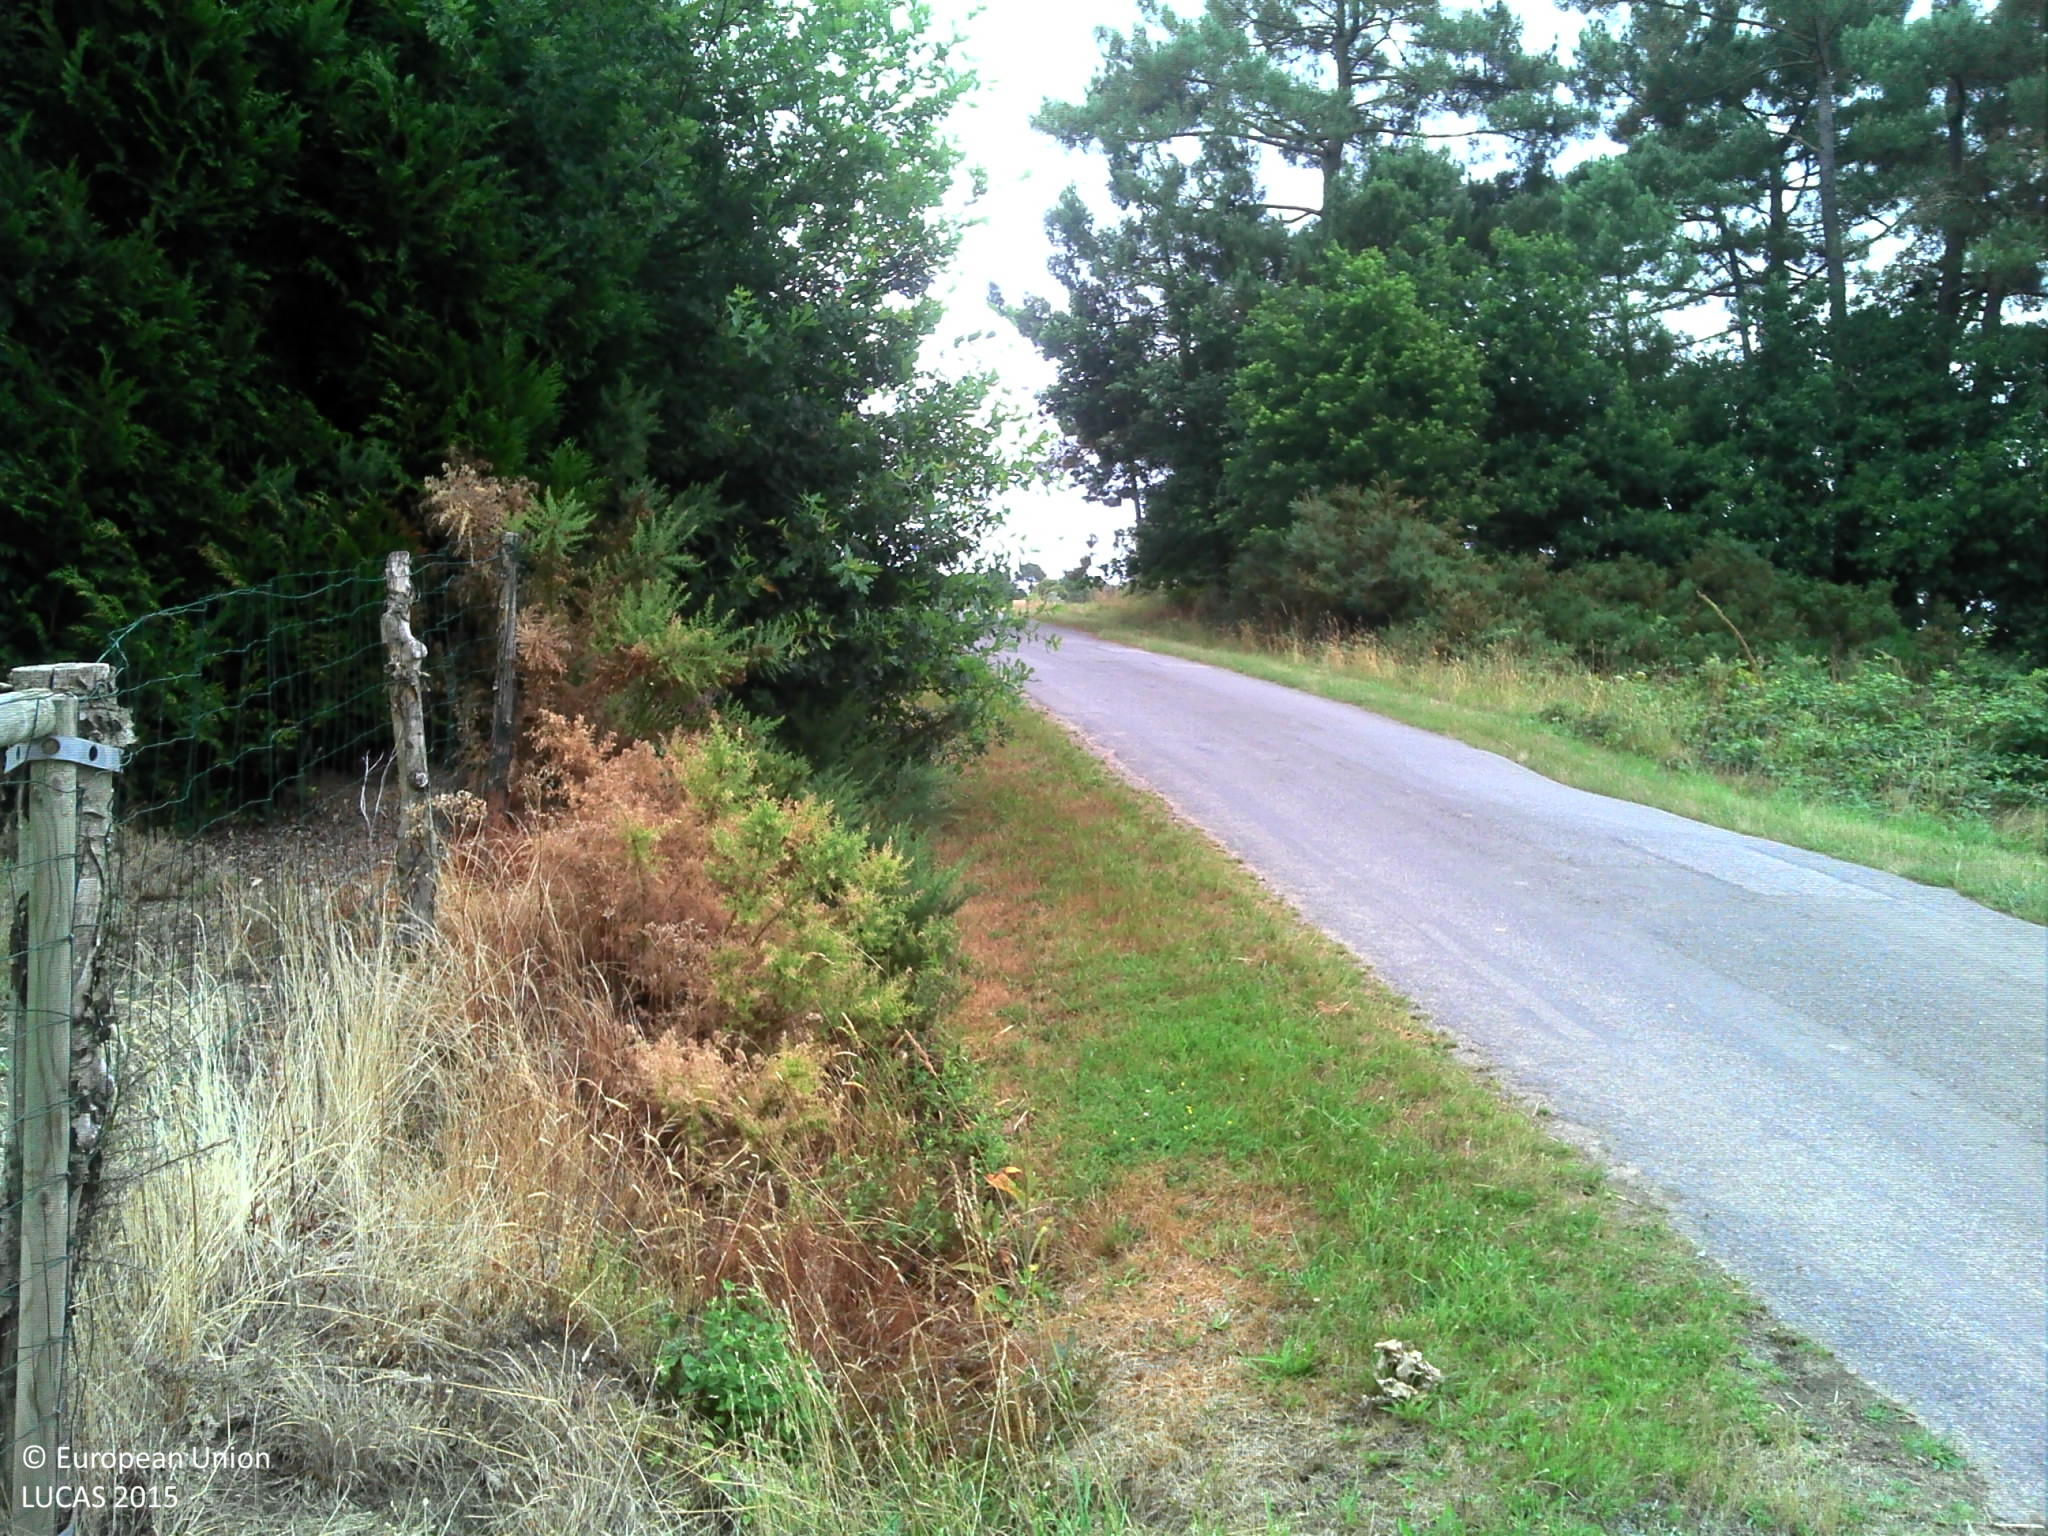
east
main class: Cropland
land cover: Apple fruit
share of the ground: 25 - 50 %
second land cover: Grassland without tree/shrub cover
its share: > 75 %
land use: Kitchen garden
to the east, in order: Apple fruit; Grassland without tree/shrub cover; Artificial constructions in urban areas; Grassland without tree/shrub cover; Common wheat
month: July
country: FR
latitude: 47.8165
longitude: -2.0314
